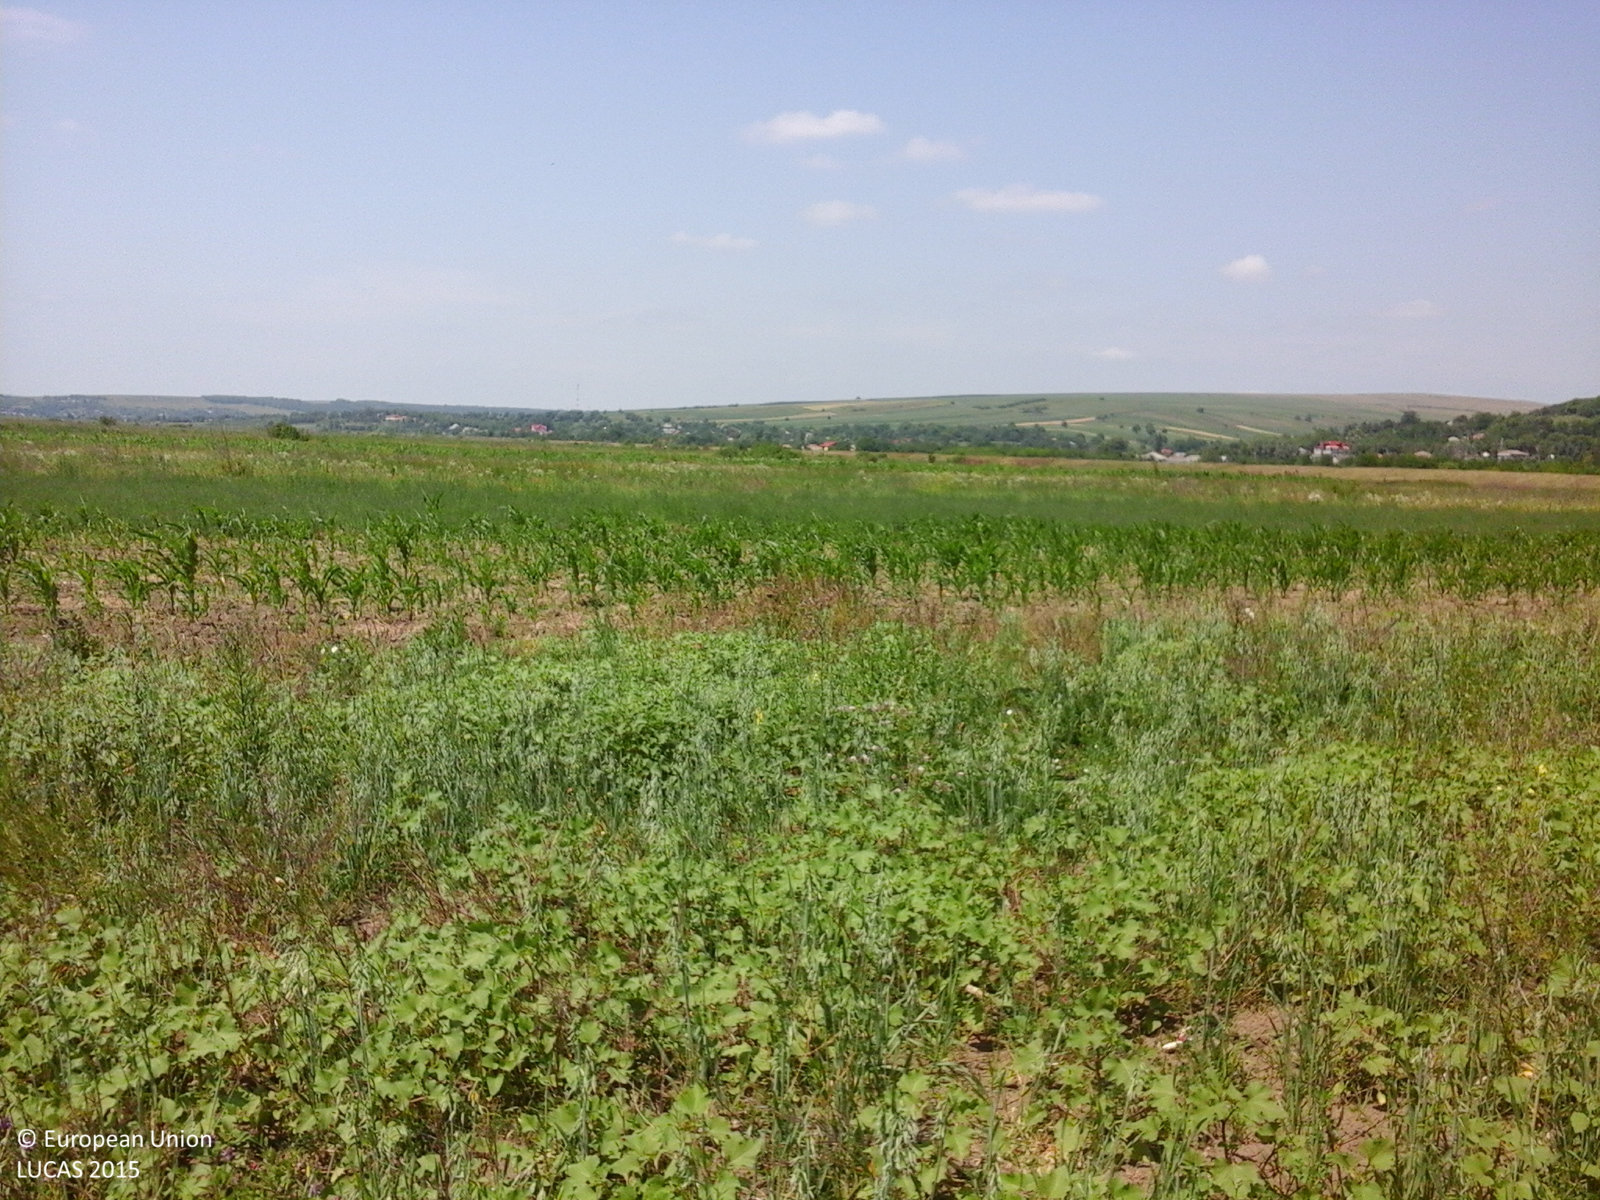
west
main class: Cropland
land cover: Lucerne
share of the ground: > 75 %
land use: Agriculture (excluding fallow land and kitchen gardens)
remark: Harvested field
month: June
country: RO
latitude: 46.8420
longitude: 27.2979
